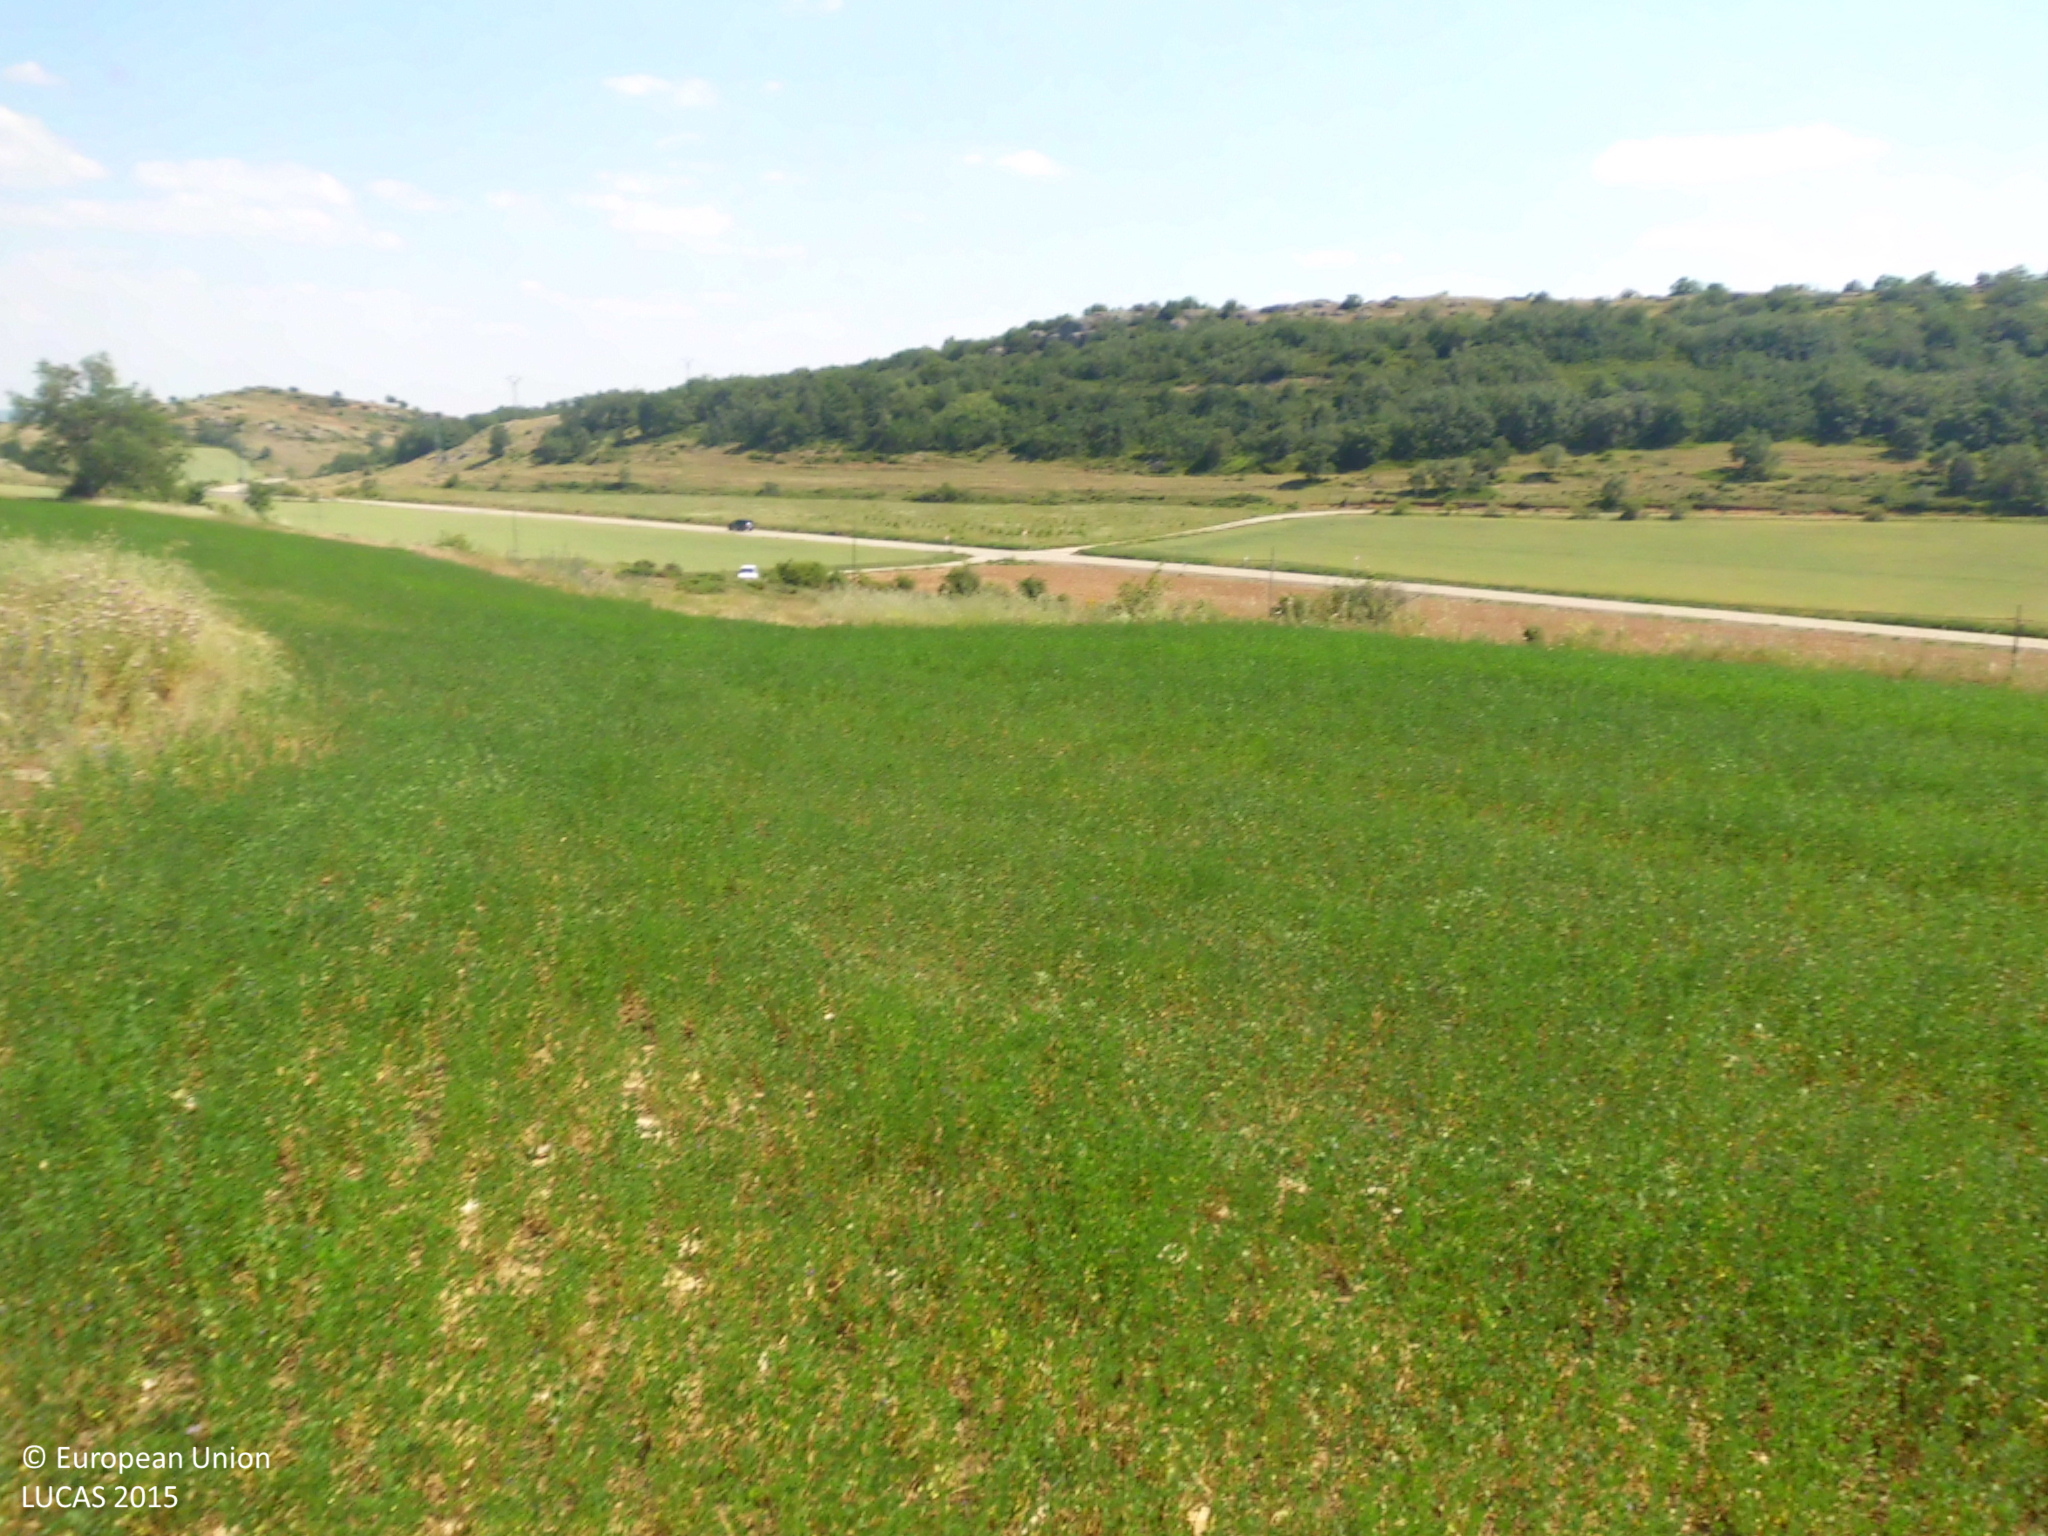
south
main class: Cropland
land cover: Lucerne
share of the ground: 50 - 75 %
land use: Agriculture (excluding fallow land and kitchen gardens)
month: June
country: ES
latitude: 42.8204
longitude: -4.4497
